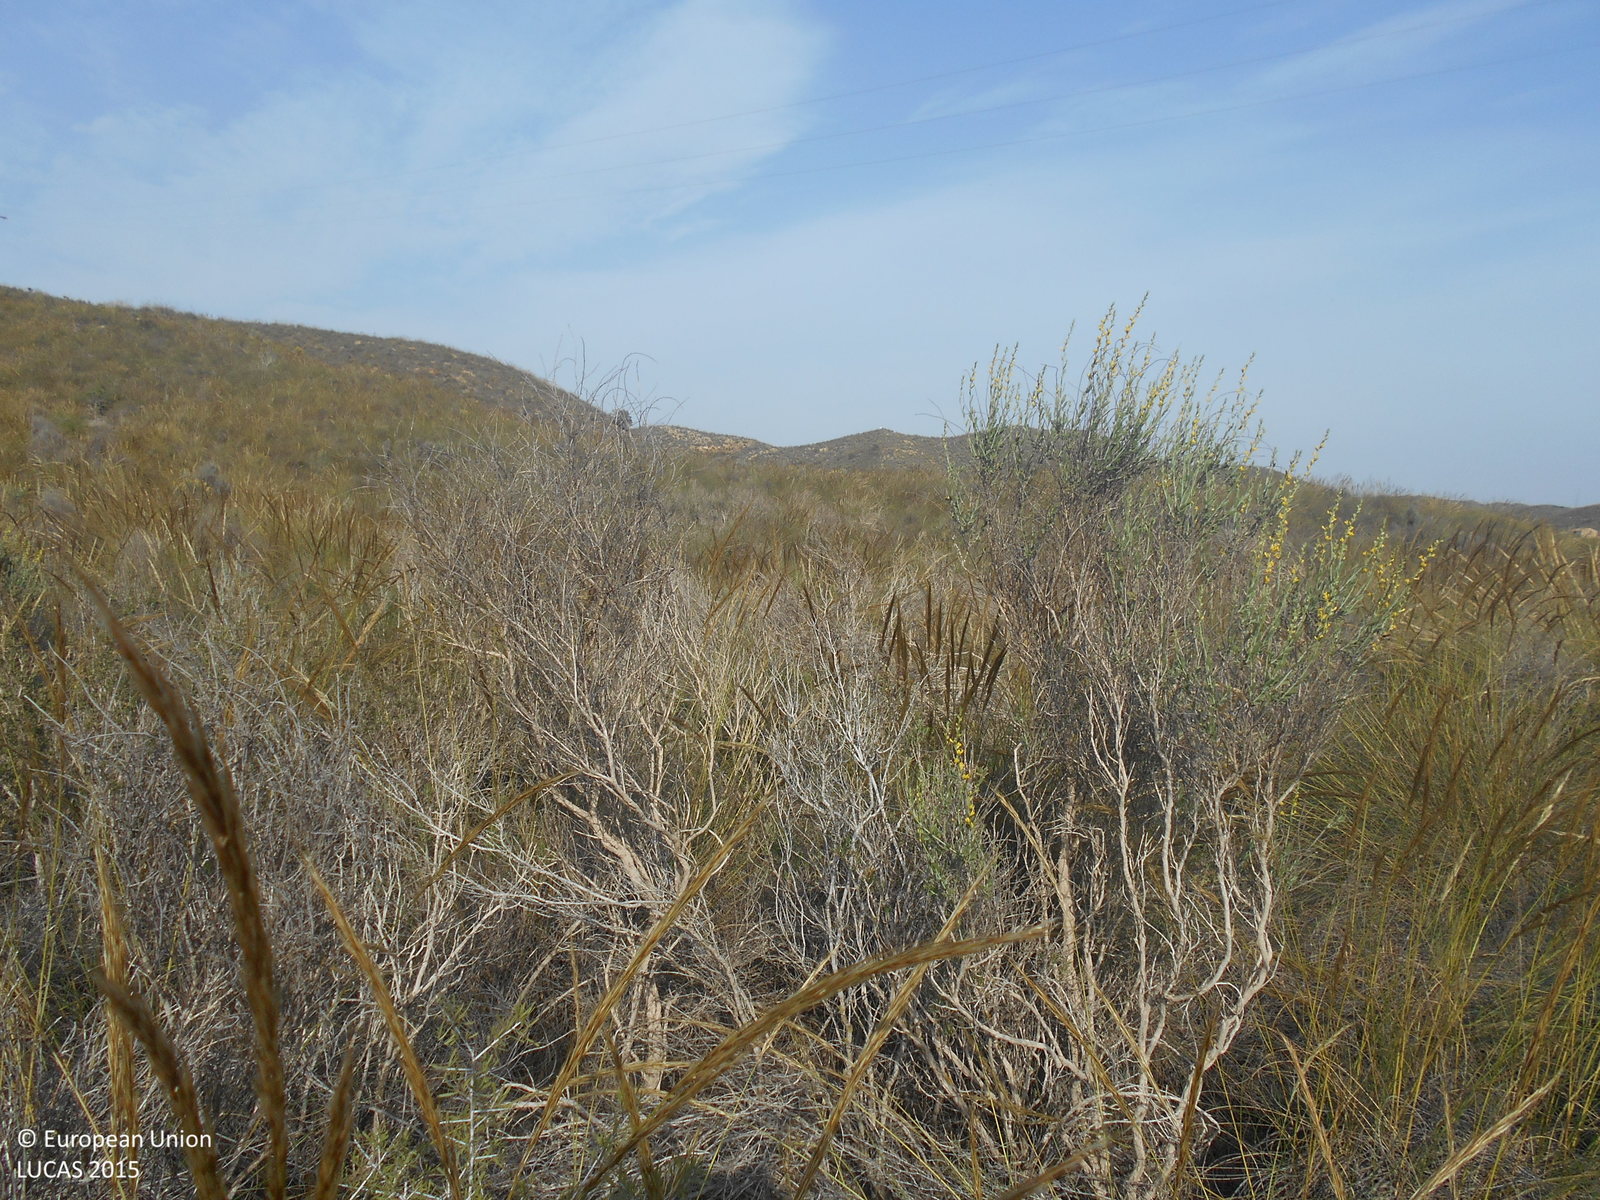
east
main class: Shrubland
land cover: Shrubland without tree cover
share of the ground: > 75 %
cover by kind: shrubs 95 %, unconsolidated bare surface 5 %
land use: Semi-natural and natural areas not in use
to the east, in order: Shrubland without tree cover; Electric lines; Shrubland without tree cover
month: April
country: ES
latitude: 37.6746
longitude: -1.3074
